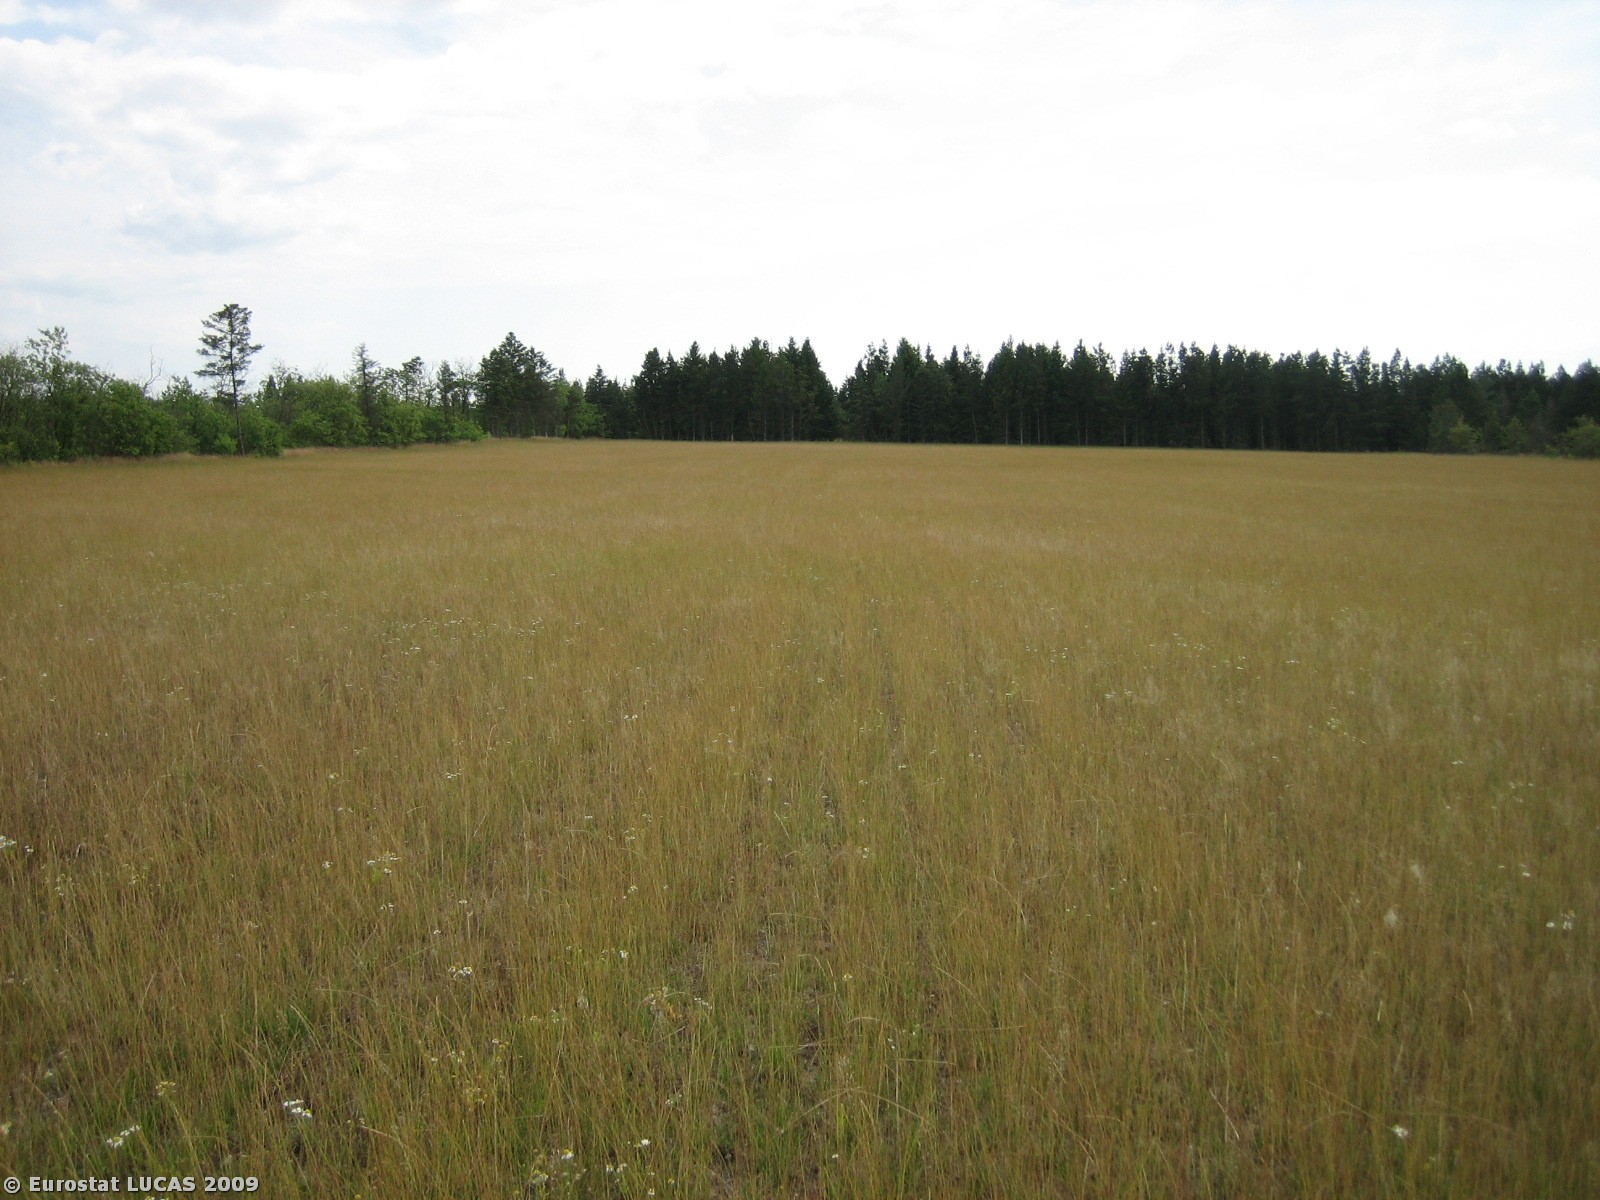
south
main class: Grassland
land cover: Grassland without tree/shrub cover
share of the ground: > 75 %
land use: Fallow land
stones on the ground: 10 - 25 %
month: July
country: DK
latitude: 55.8403
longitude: 8.7717
